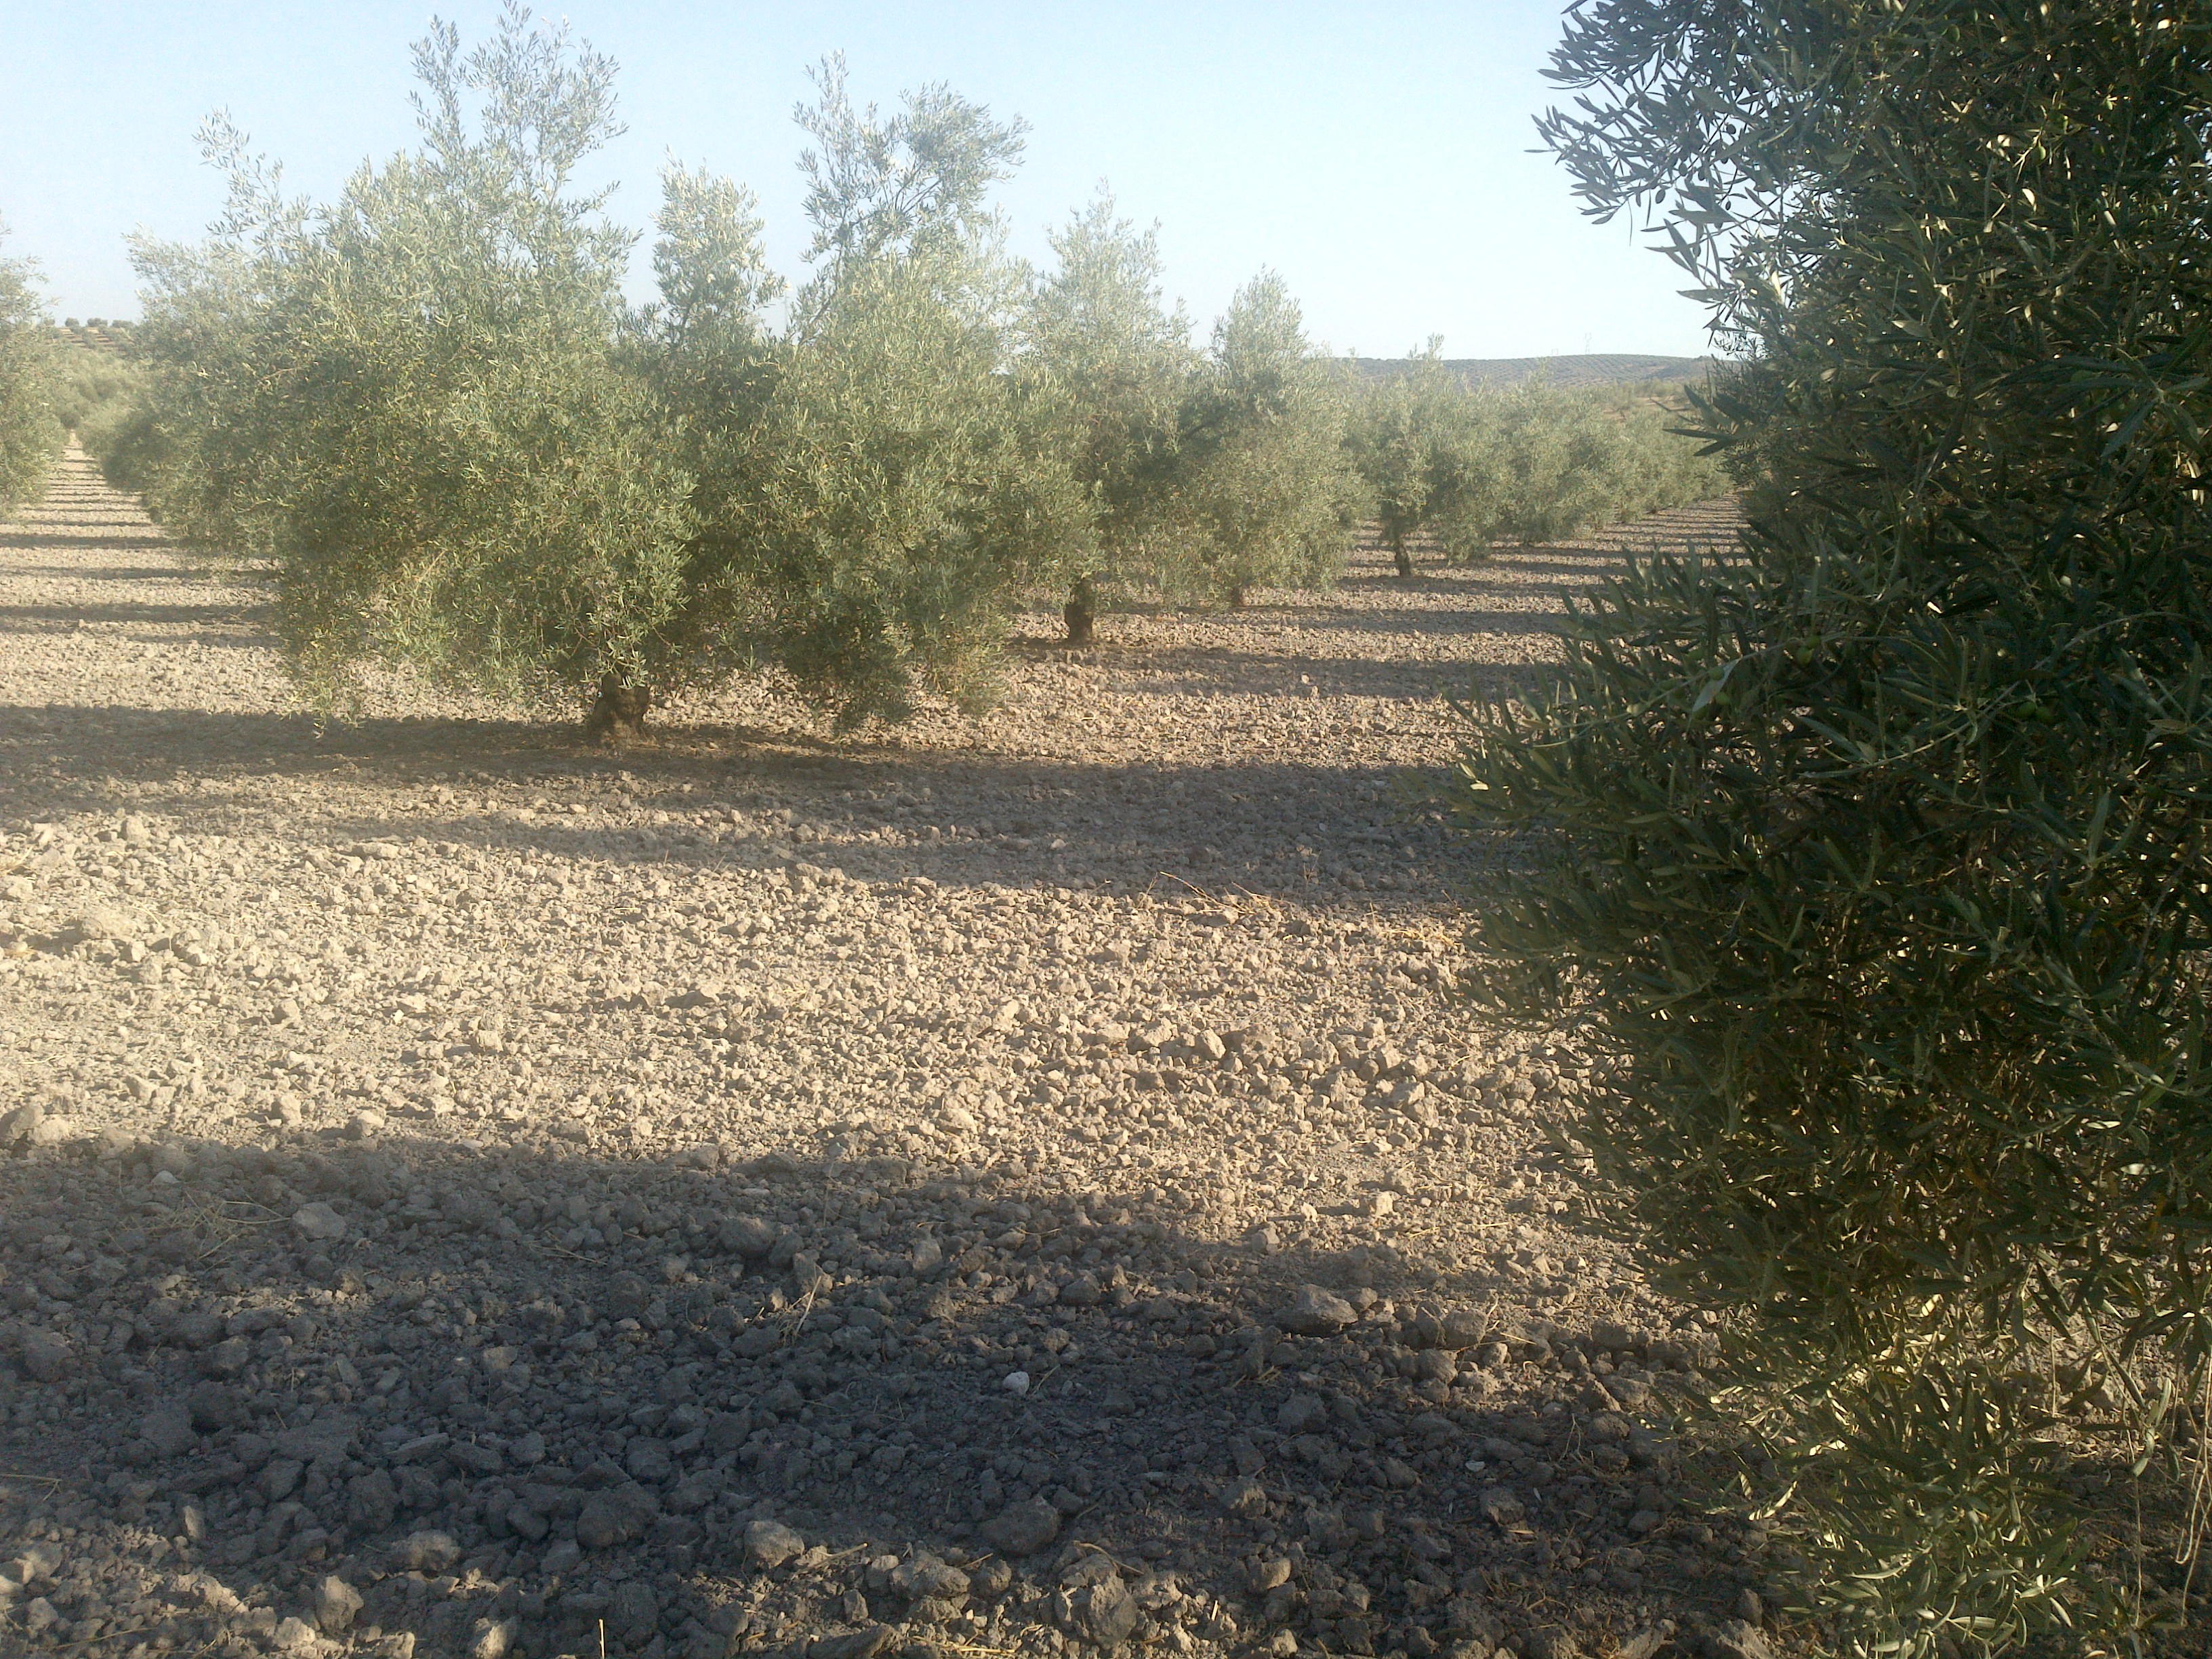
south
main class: Cropland
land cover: Olive groves
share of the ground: 25 - 50 %
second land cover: Other bare soil
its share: > 75 %
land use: Agriculture (excluding fallow land and kitchen gardens)
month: June
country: ES
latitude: 37.3746
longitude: -4.5591
